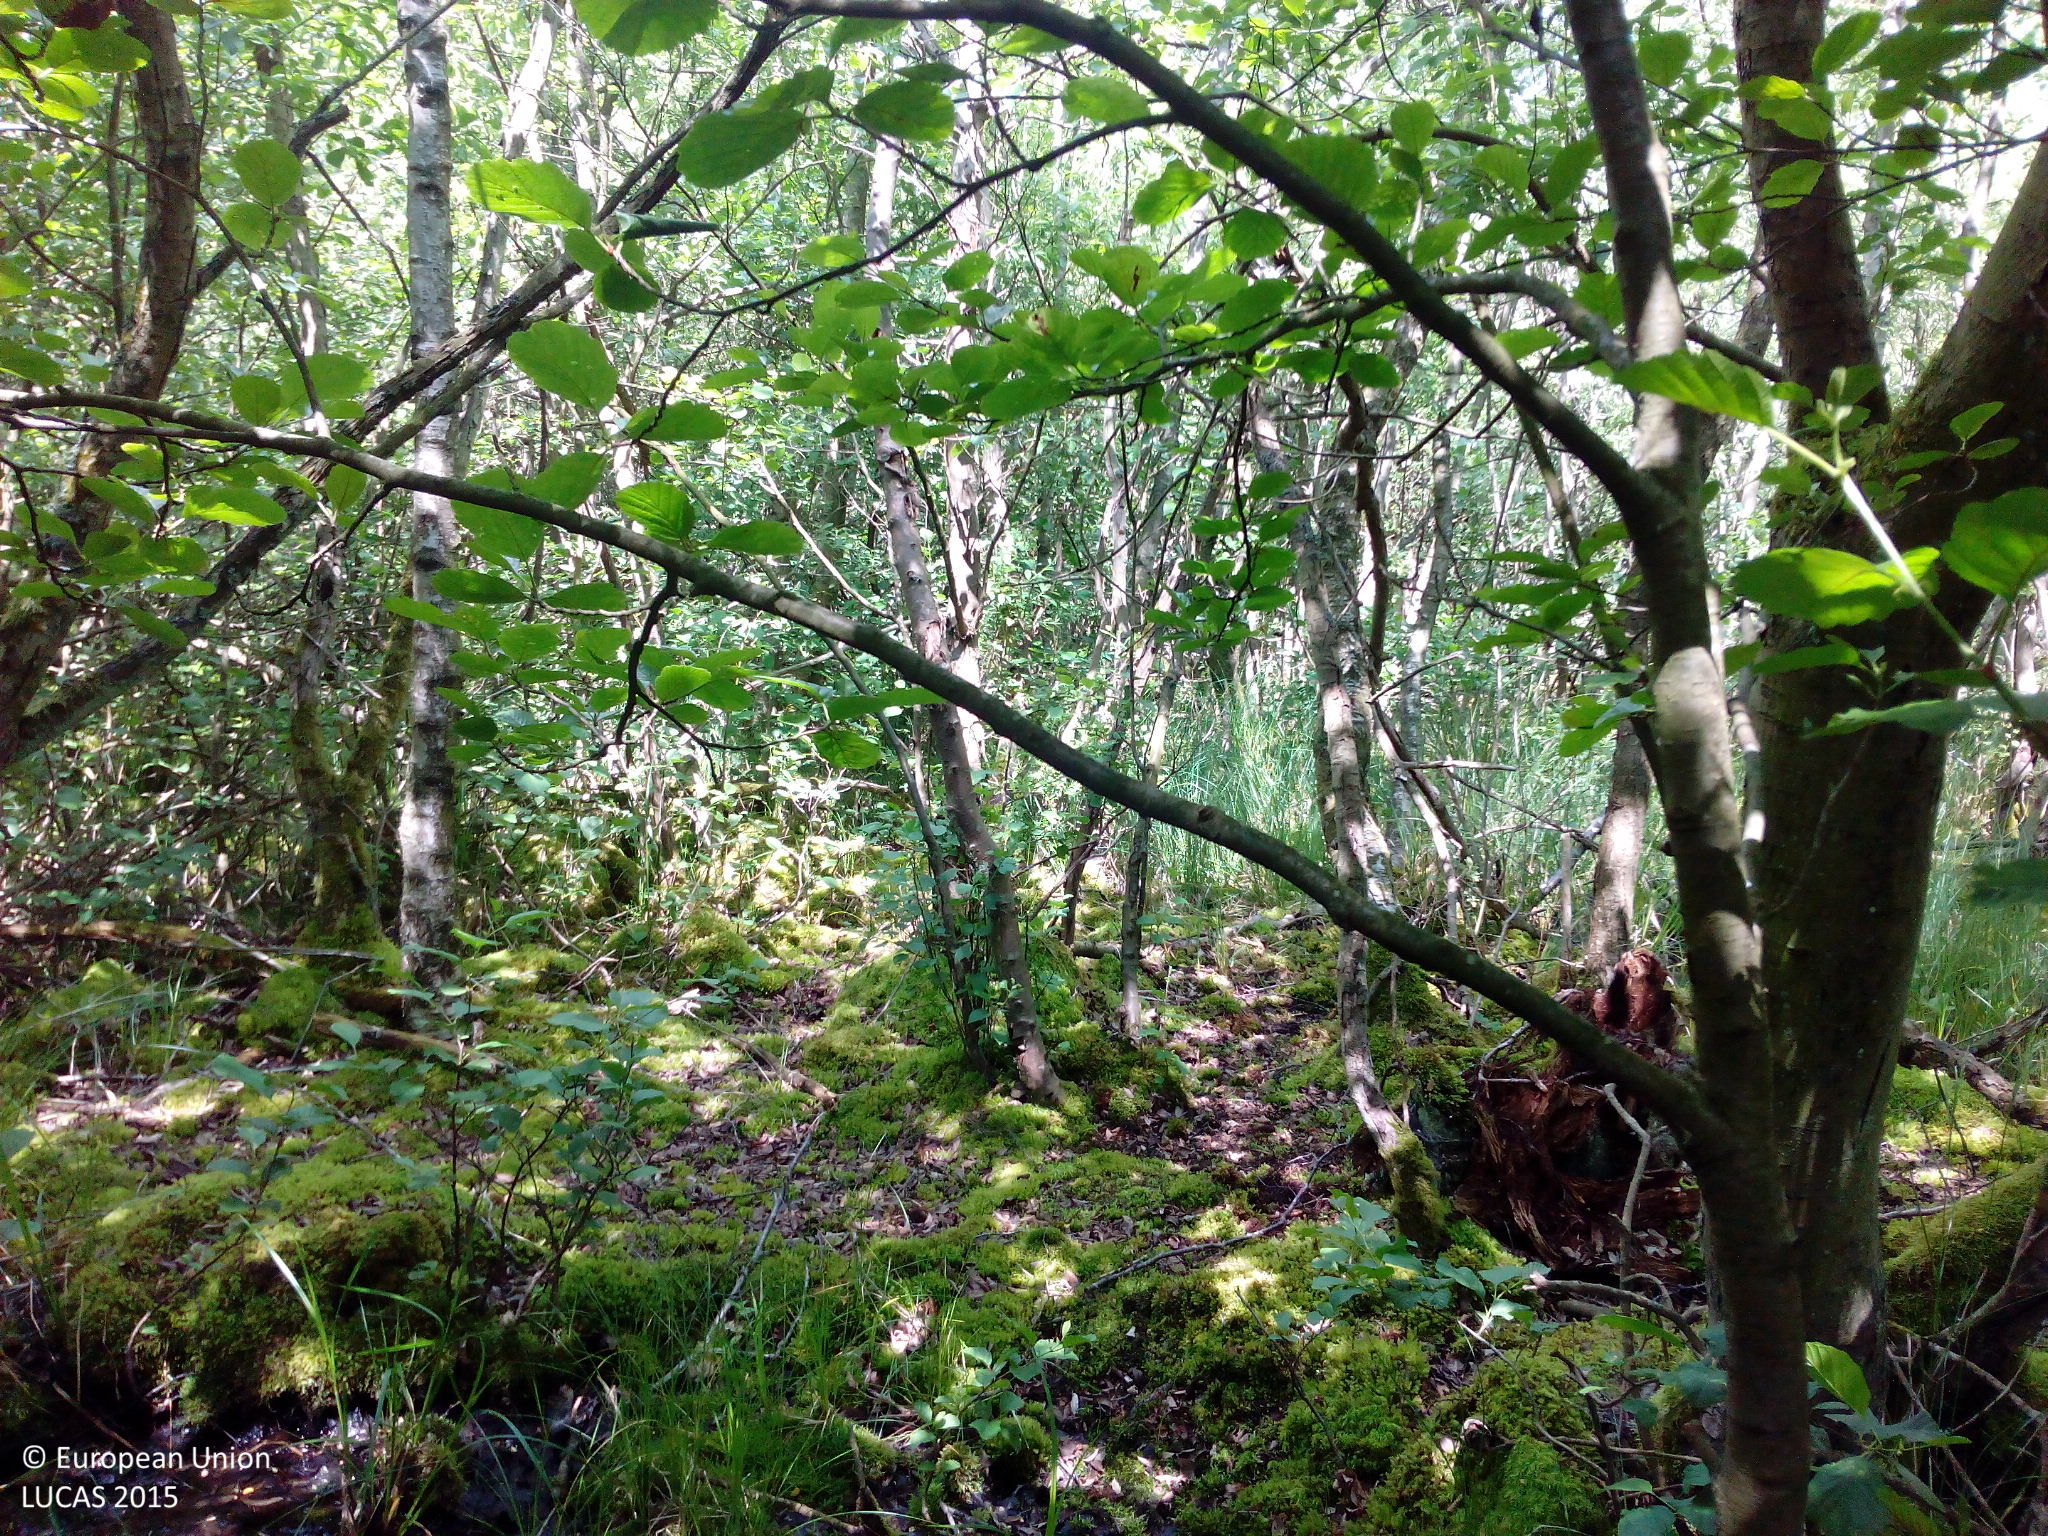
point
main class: Woodland
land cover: Broadleaved woodland
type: mesophytic deciduous forest
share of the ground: 50 - 75 %
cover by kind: broadleaved forest trees 70 %, herbaceous plants 15 %, lichens and mosses 10 %, shrubs 5 %
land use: Semi-natural and natural areas not in use
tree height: > 5 m
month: June
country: DK
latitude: 56.2579
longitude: 10.6610
